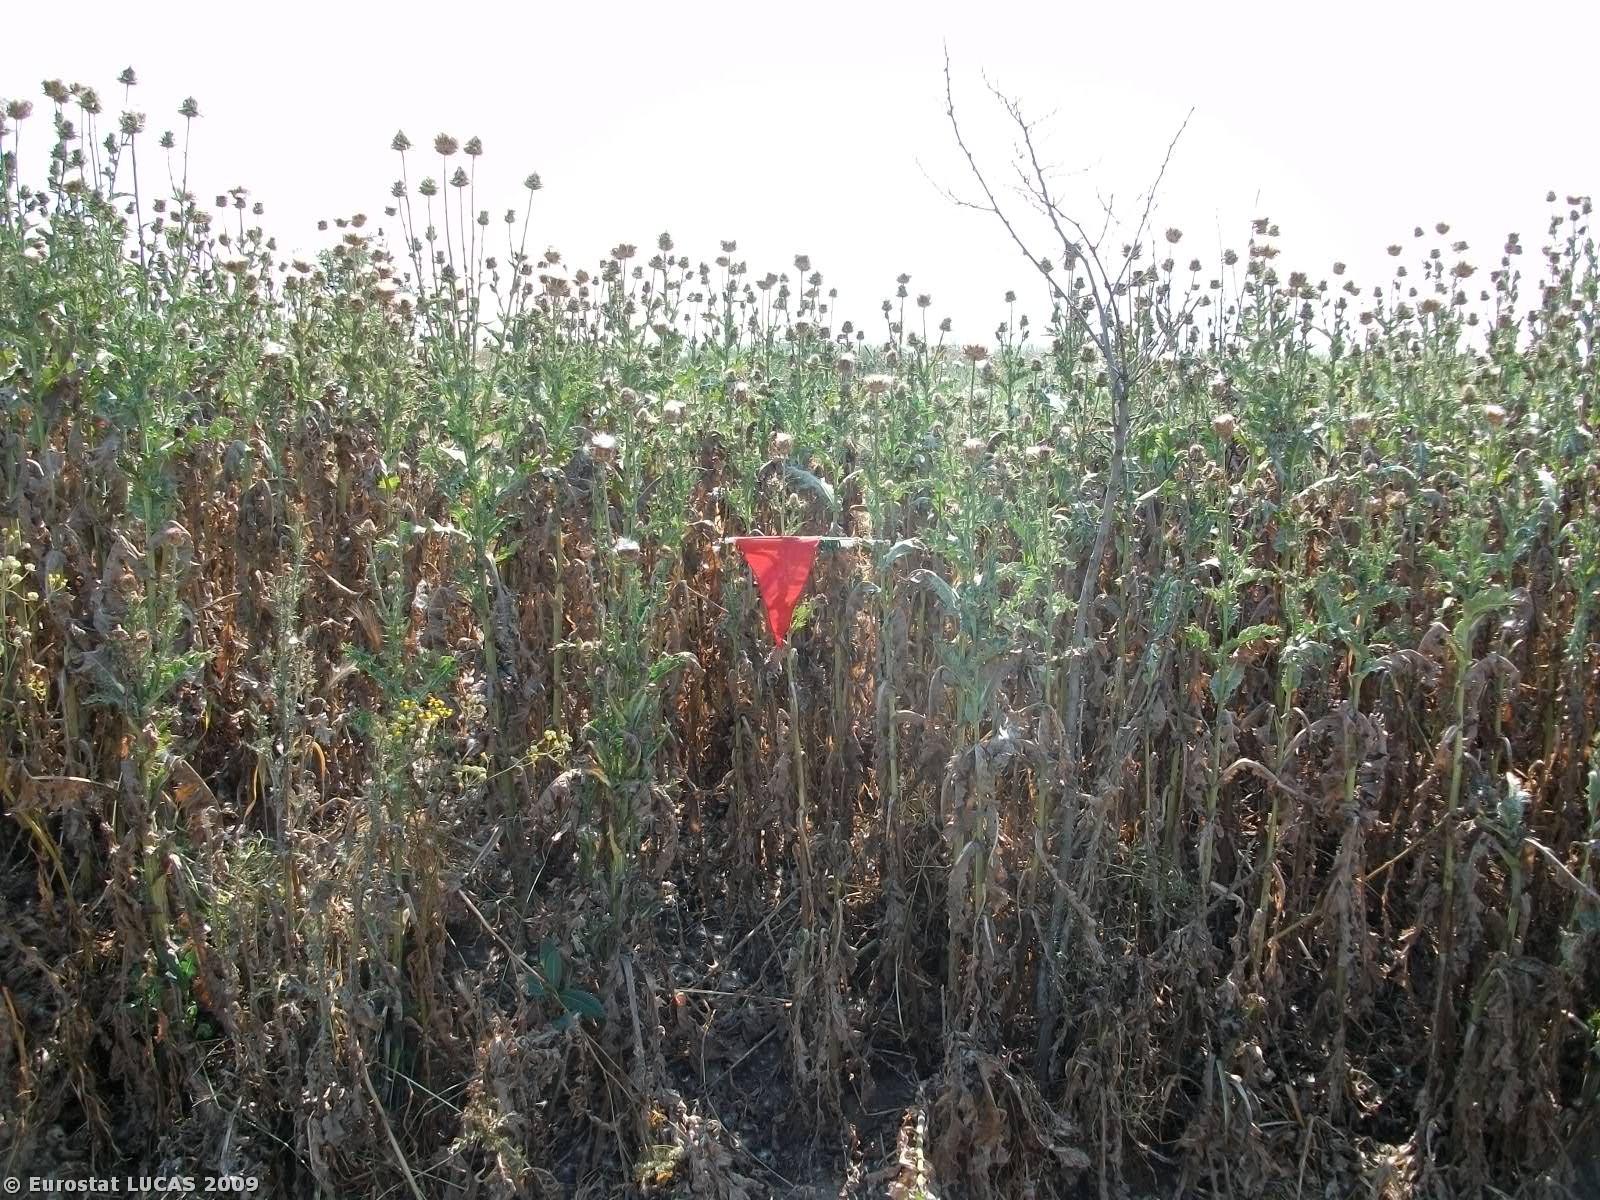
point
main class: Grassland
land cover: Spontaneously vegetated surfaces
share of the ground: > 75 %
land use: Unused
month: May
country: GR
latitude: 39.7312
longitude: 22.4170
